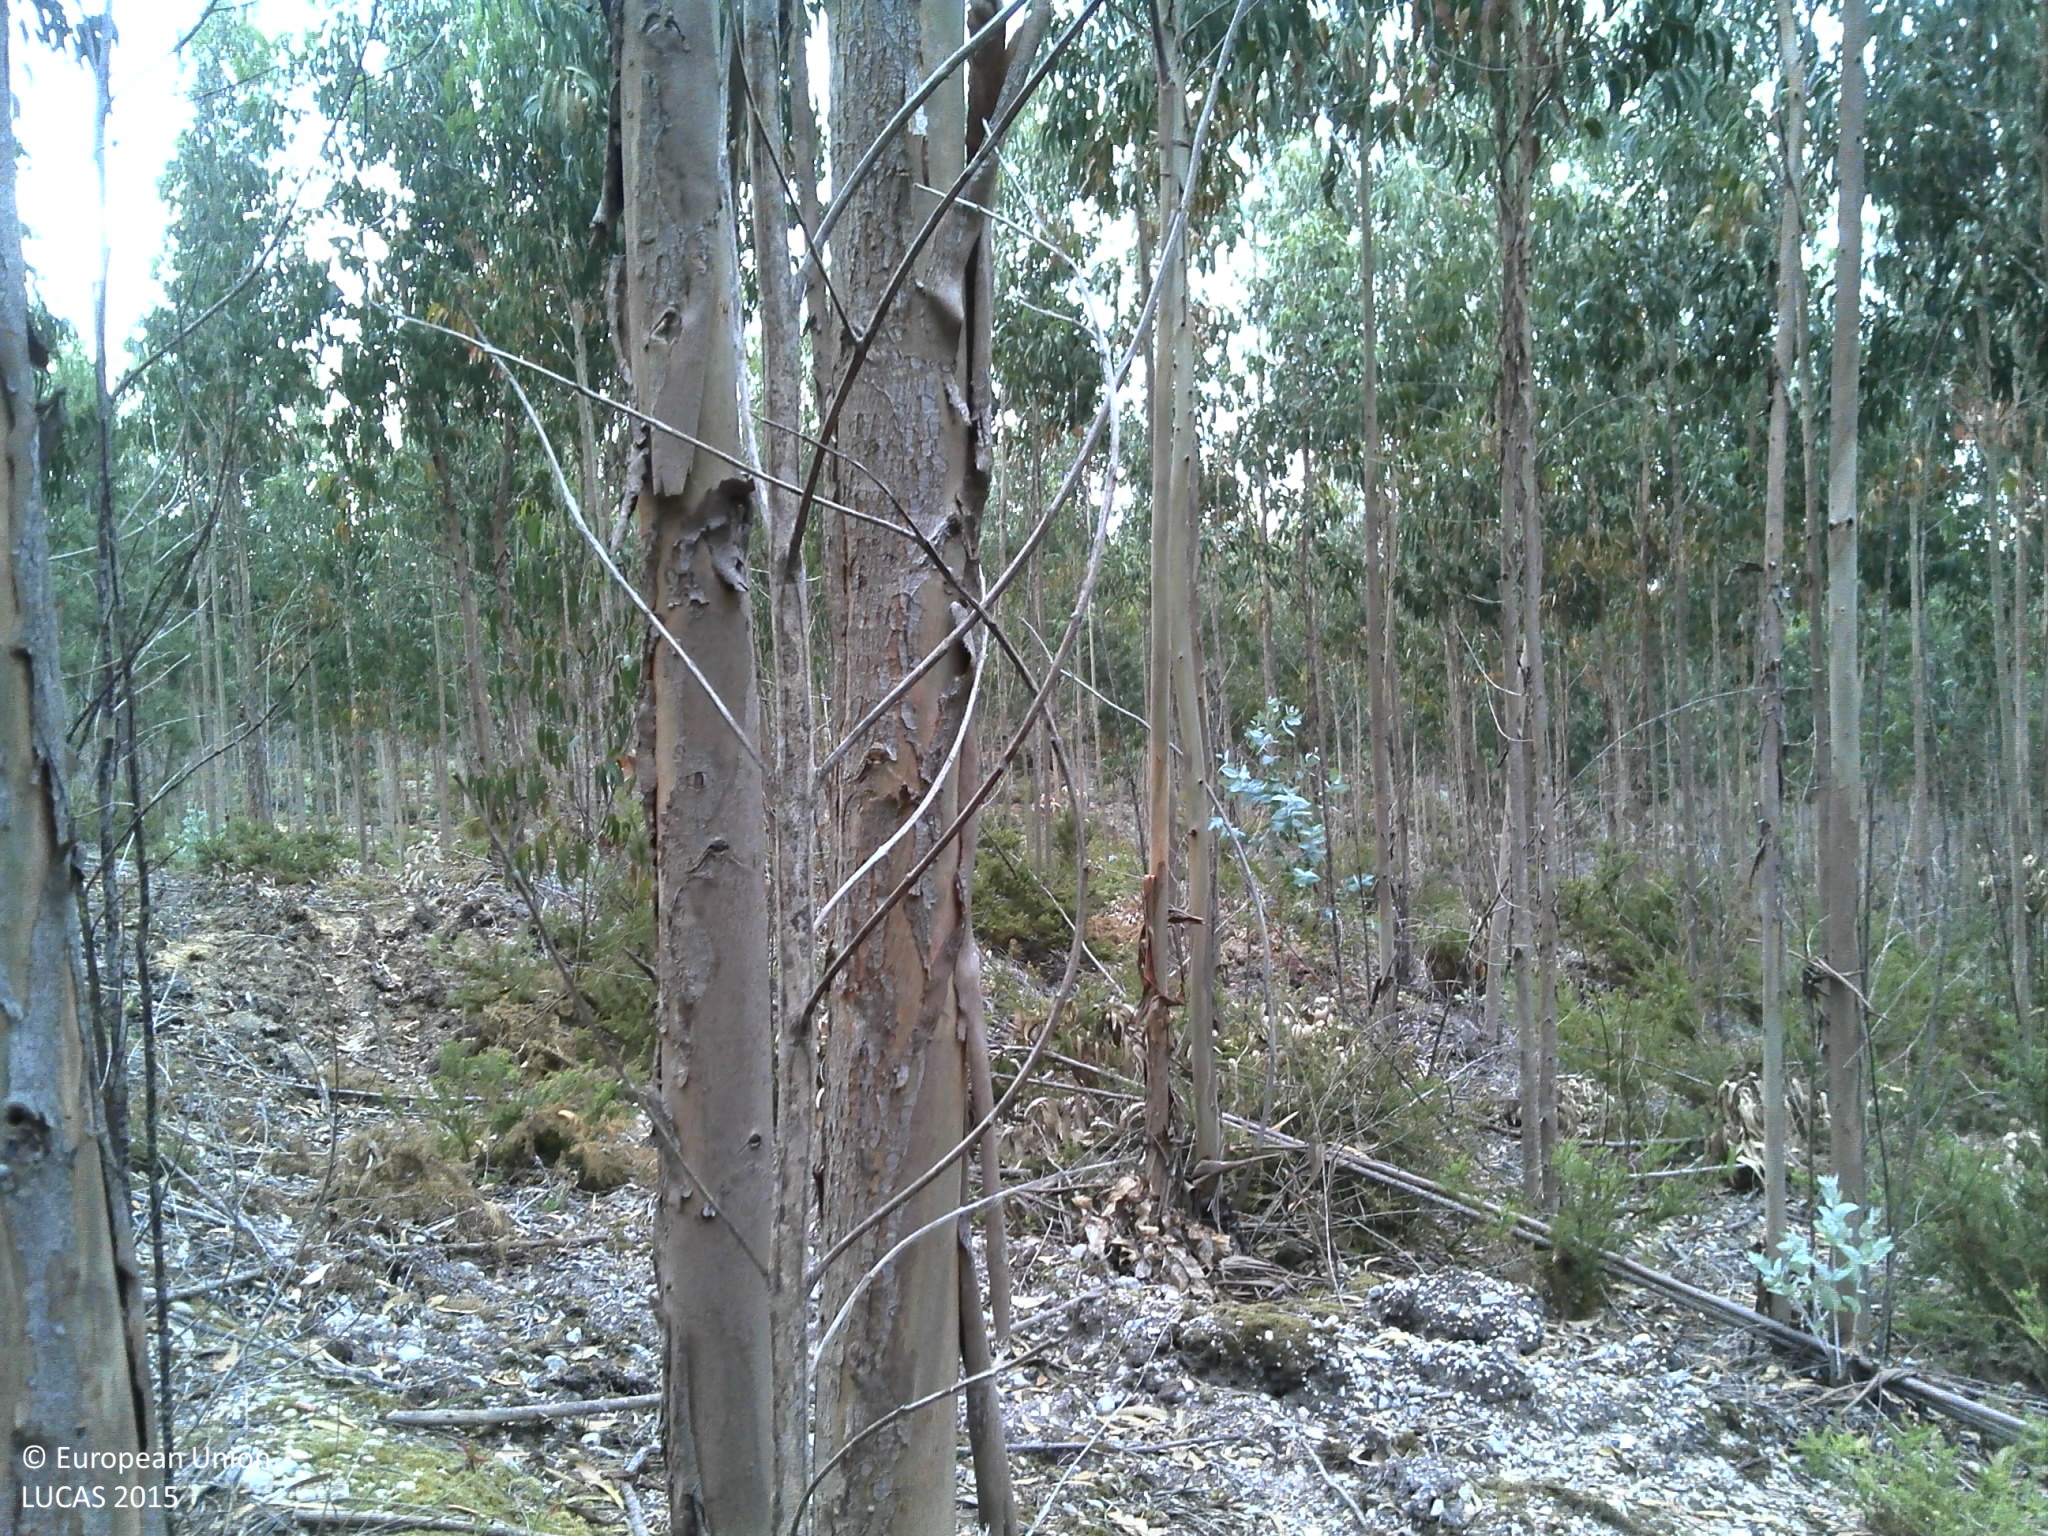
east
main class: Woodland
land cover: Broadleaved woodland
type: exotic forest
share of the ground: 50 - 75 %
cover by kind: broadleaved forest trees 60 %, unconsolidated bare surface 25 %, shrubs 15 %
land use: Forestry
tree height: > 5 m
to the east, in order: Broadleaved woodland; Tracks; Broadleaved woodland
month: June
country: PT
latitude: 39.3991
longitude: -9.2404
